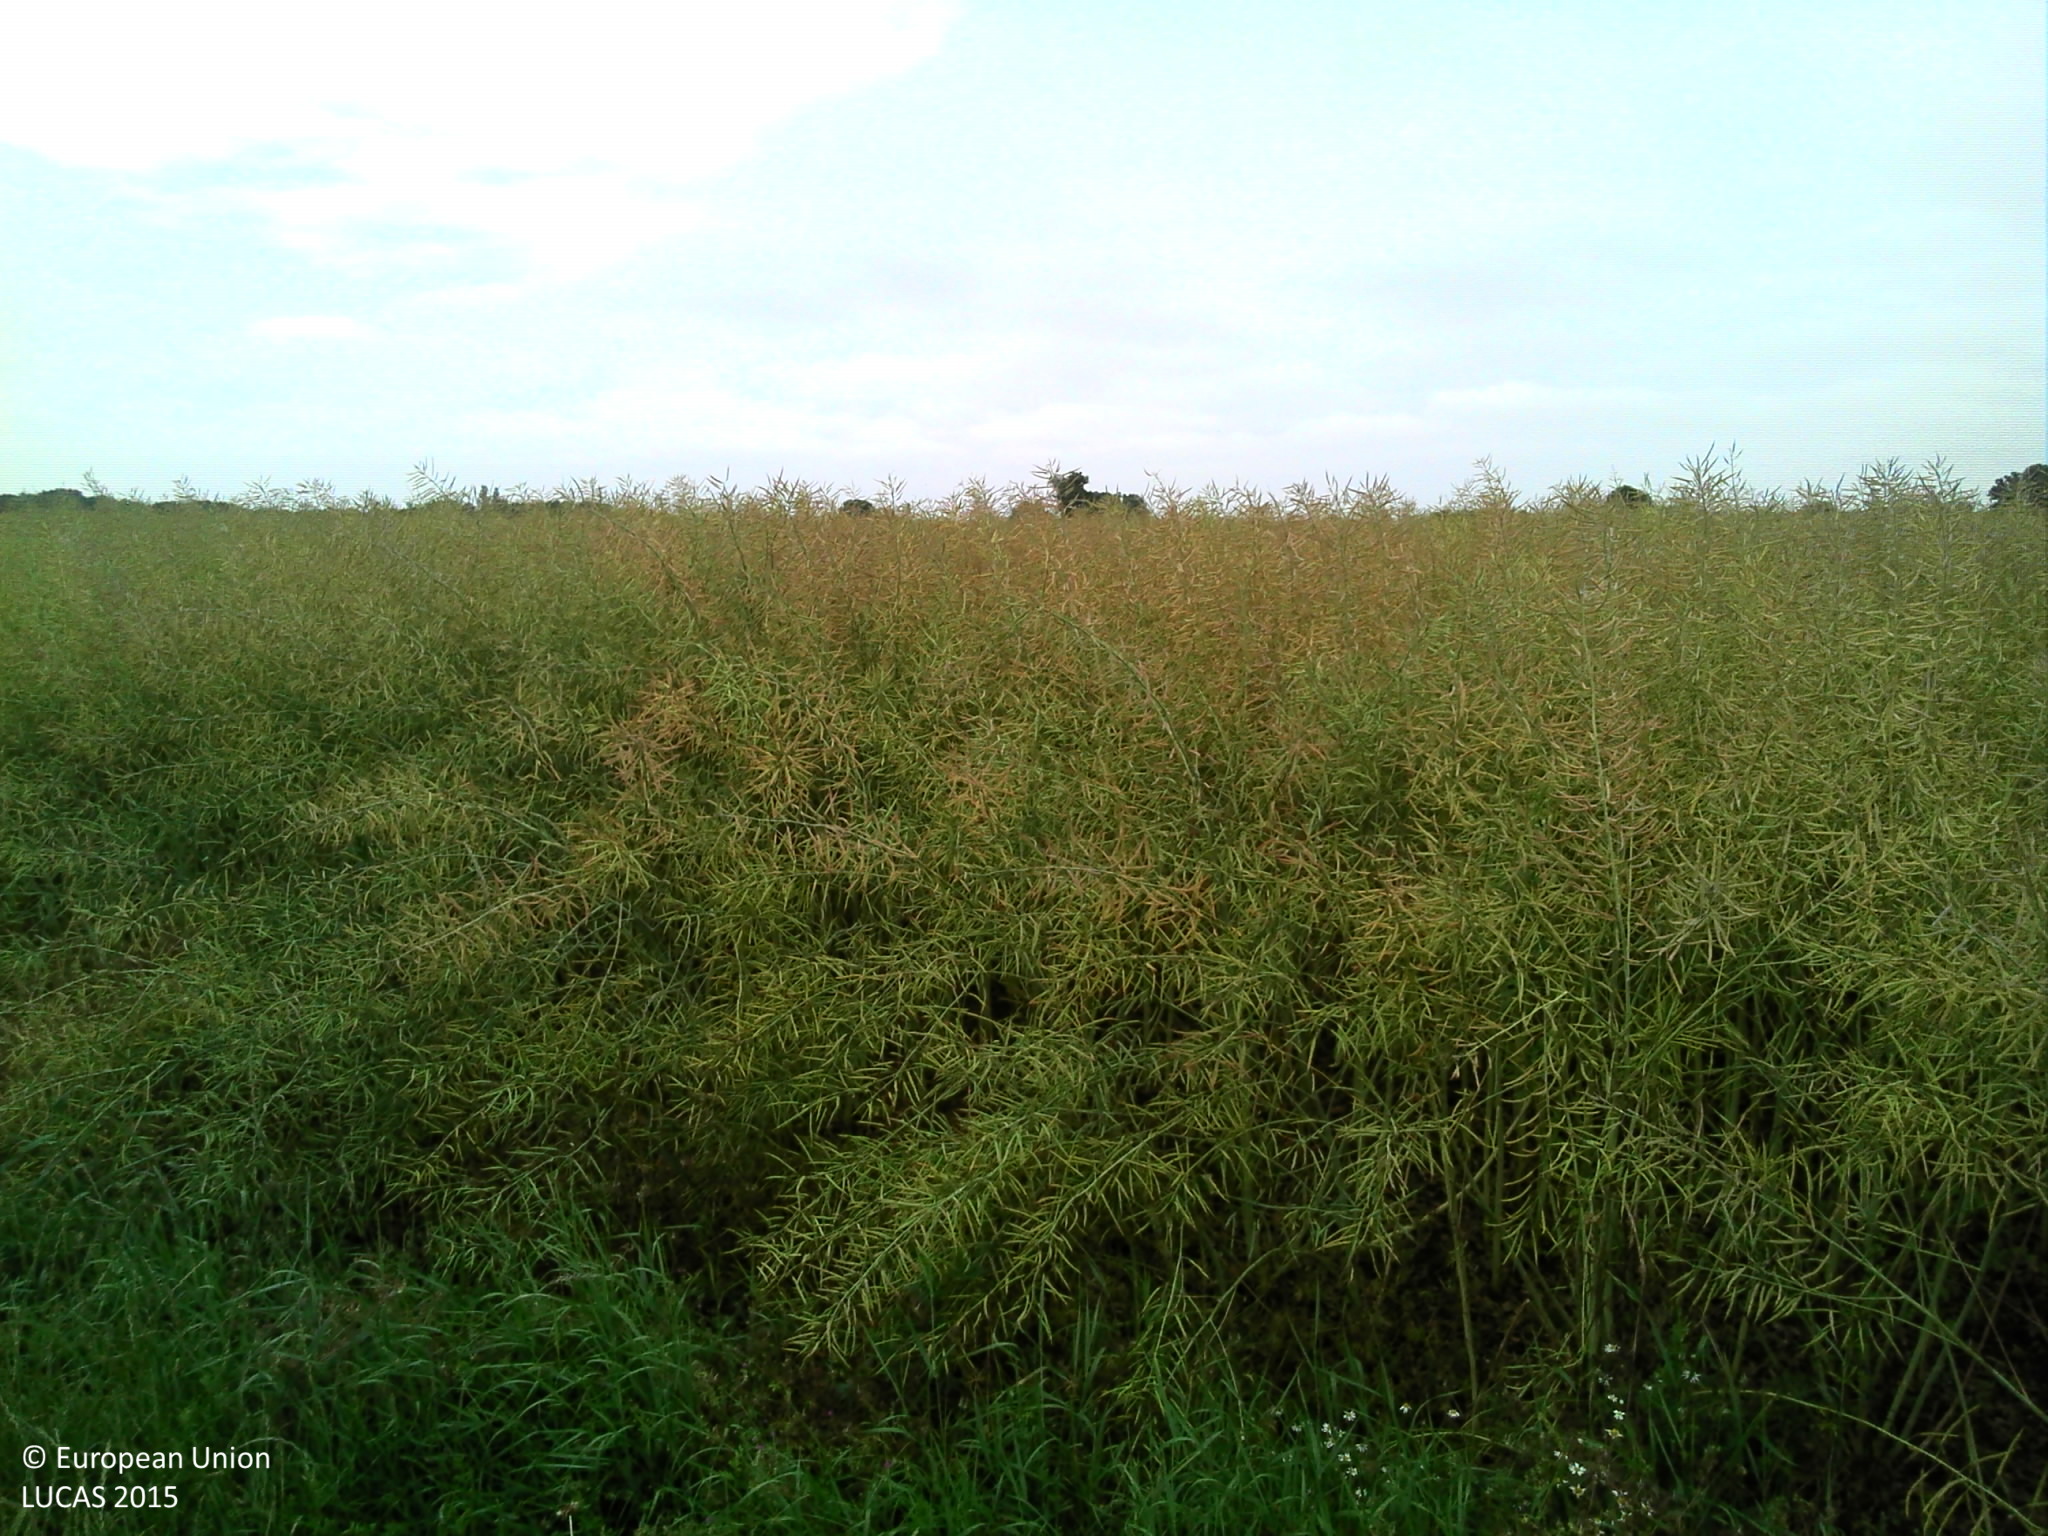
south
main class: Cropland
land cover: Rape and turnip rape
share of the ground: > 75 %
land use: Agriculture (excluding fallow land and kitchen gardens)
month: June
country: FR
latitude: 46.5285
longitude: 0.5308
